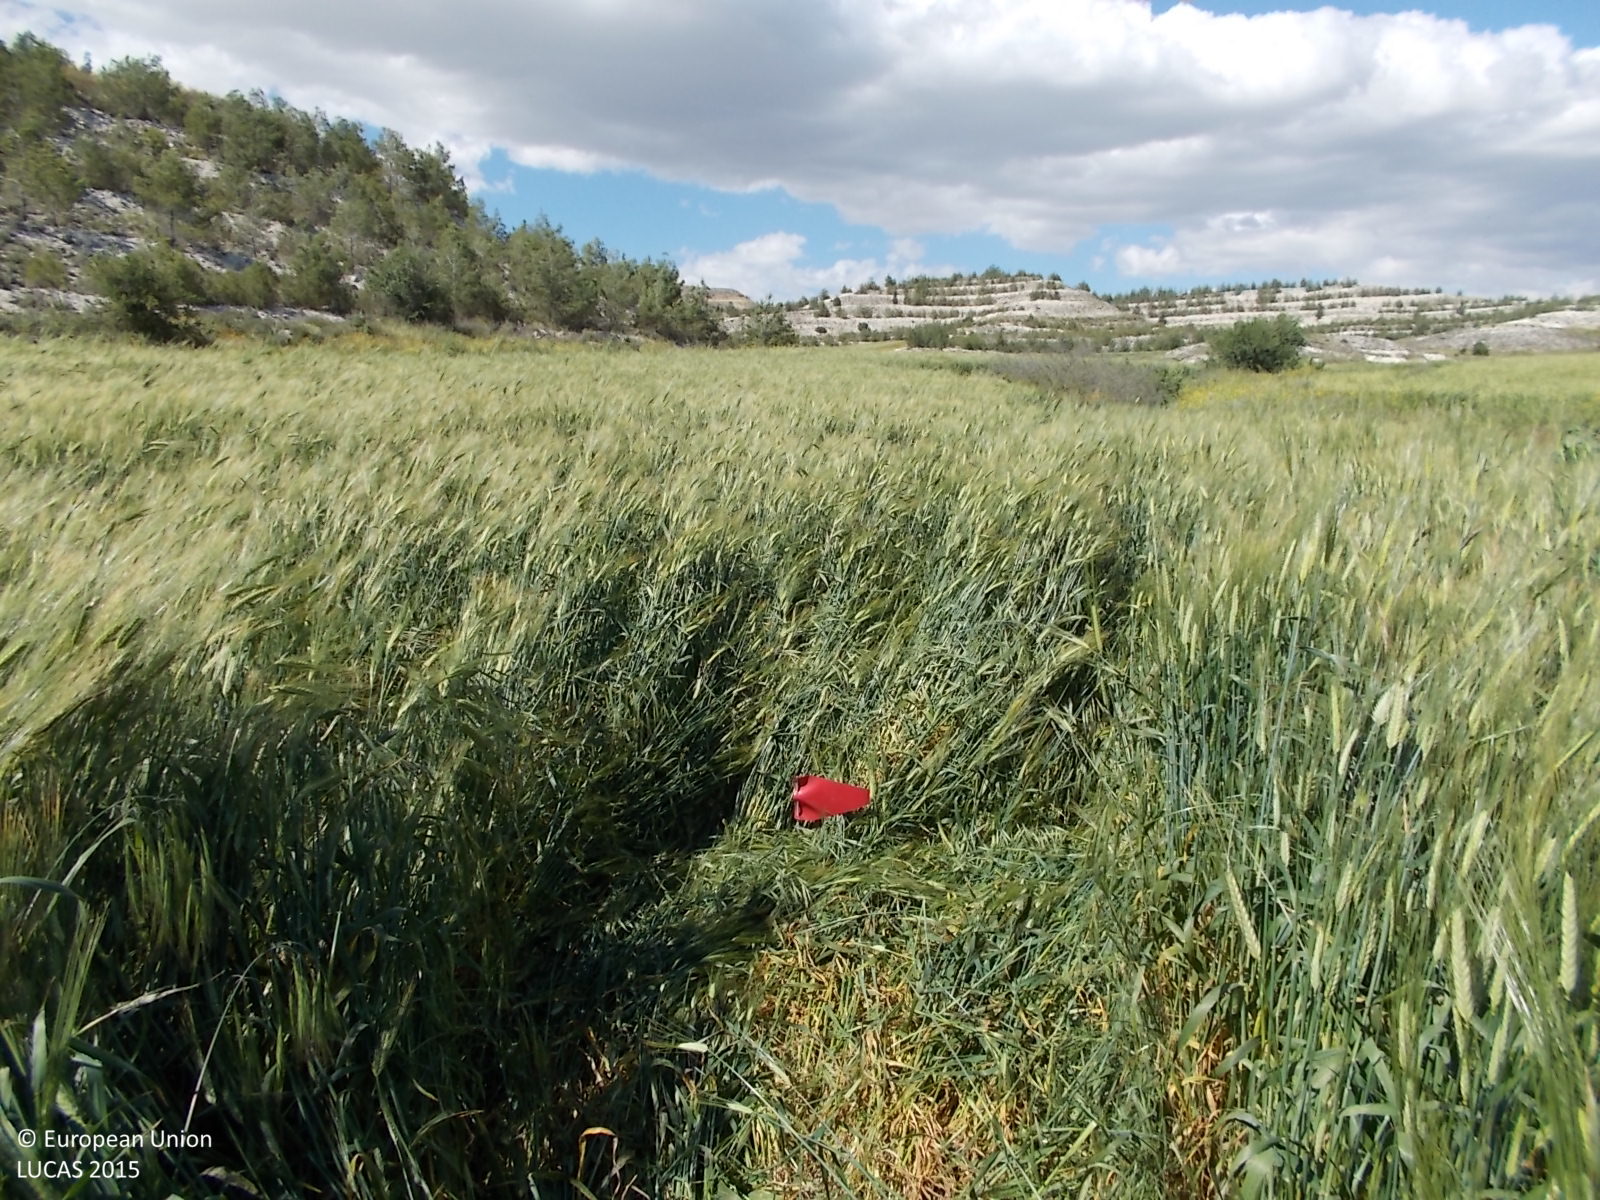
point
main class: Cropland
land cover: Barley
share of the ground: > 75 %
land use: Agriculture (excluding fallow land and kitchen gardens)
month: April
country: CY
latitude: 34.9971
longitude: 33.5208
